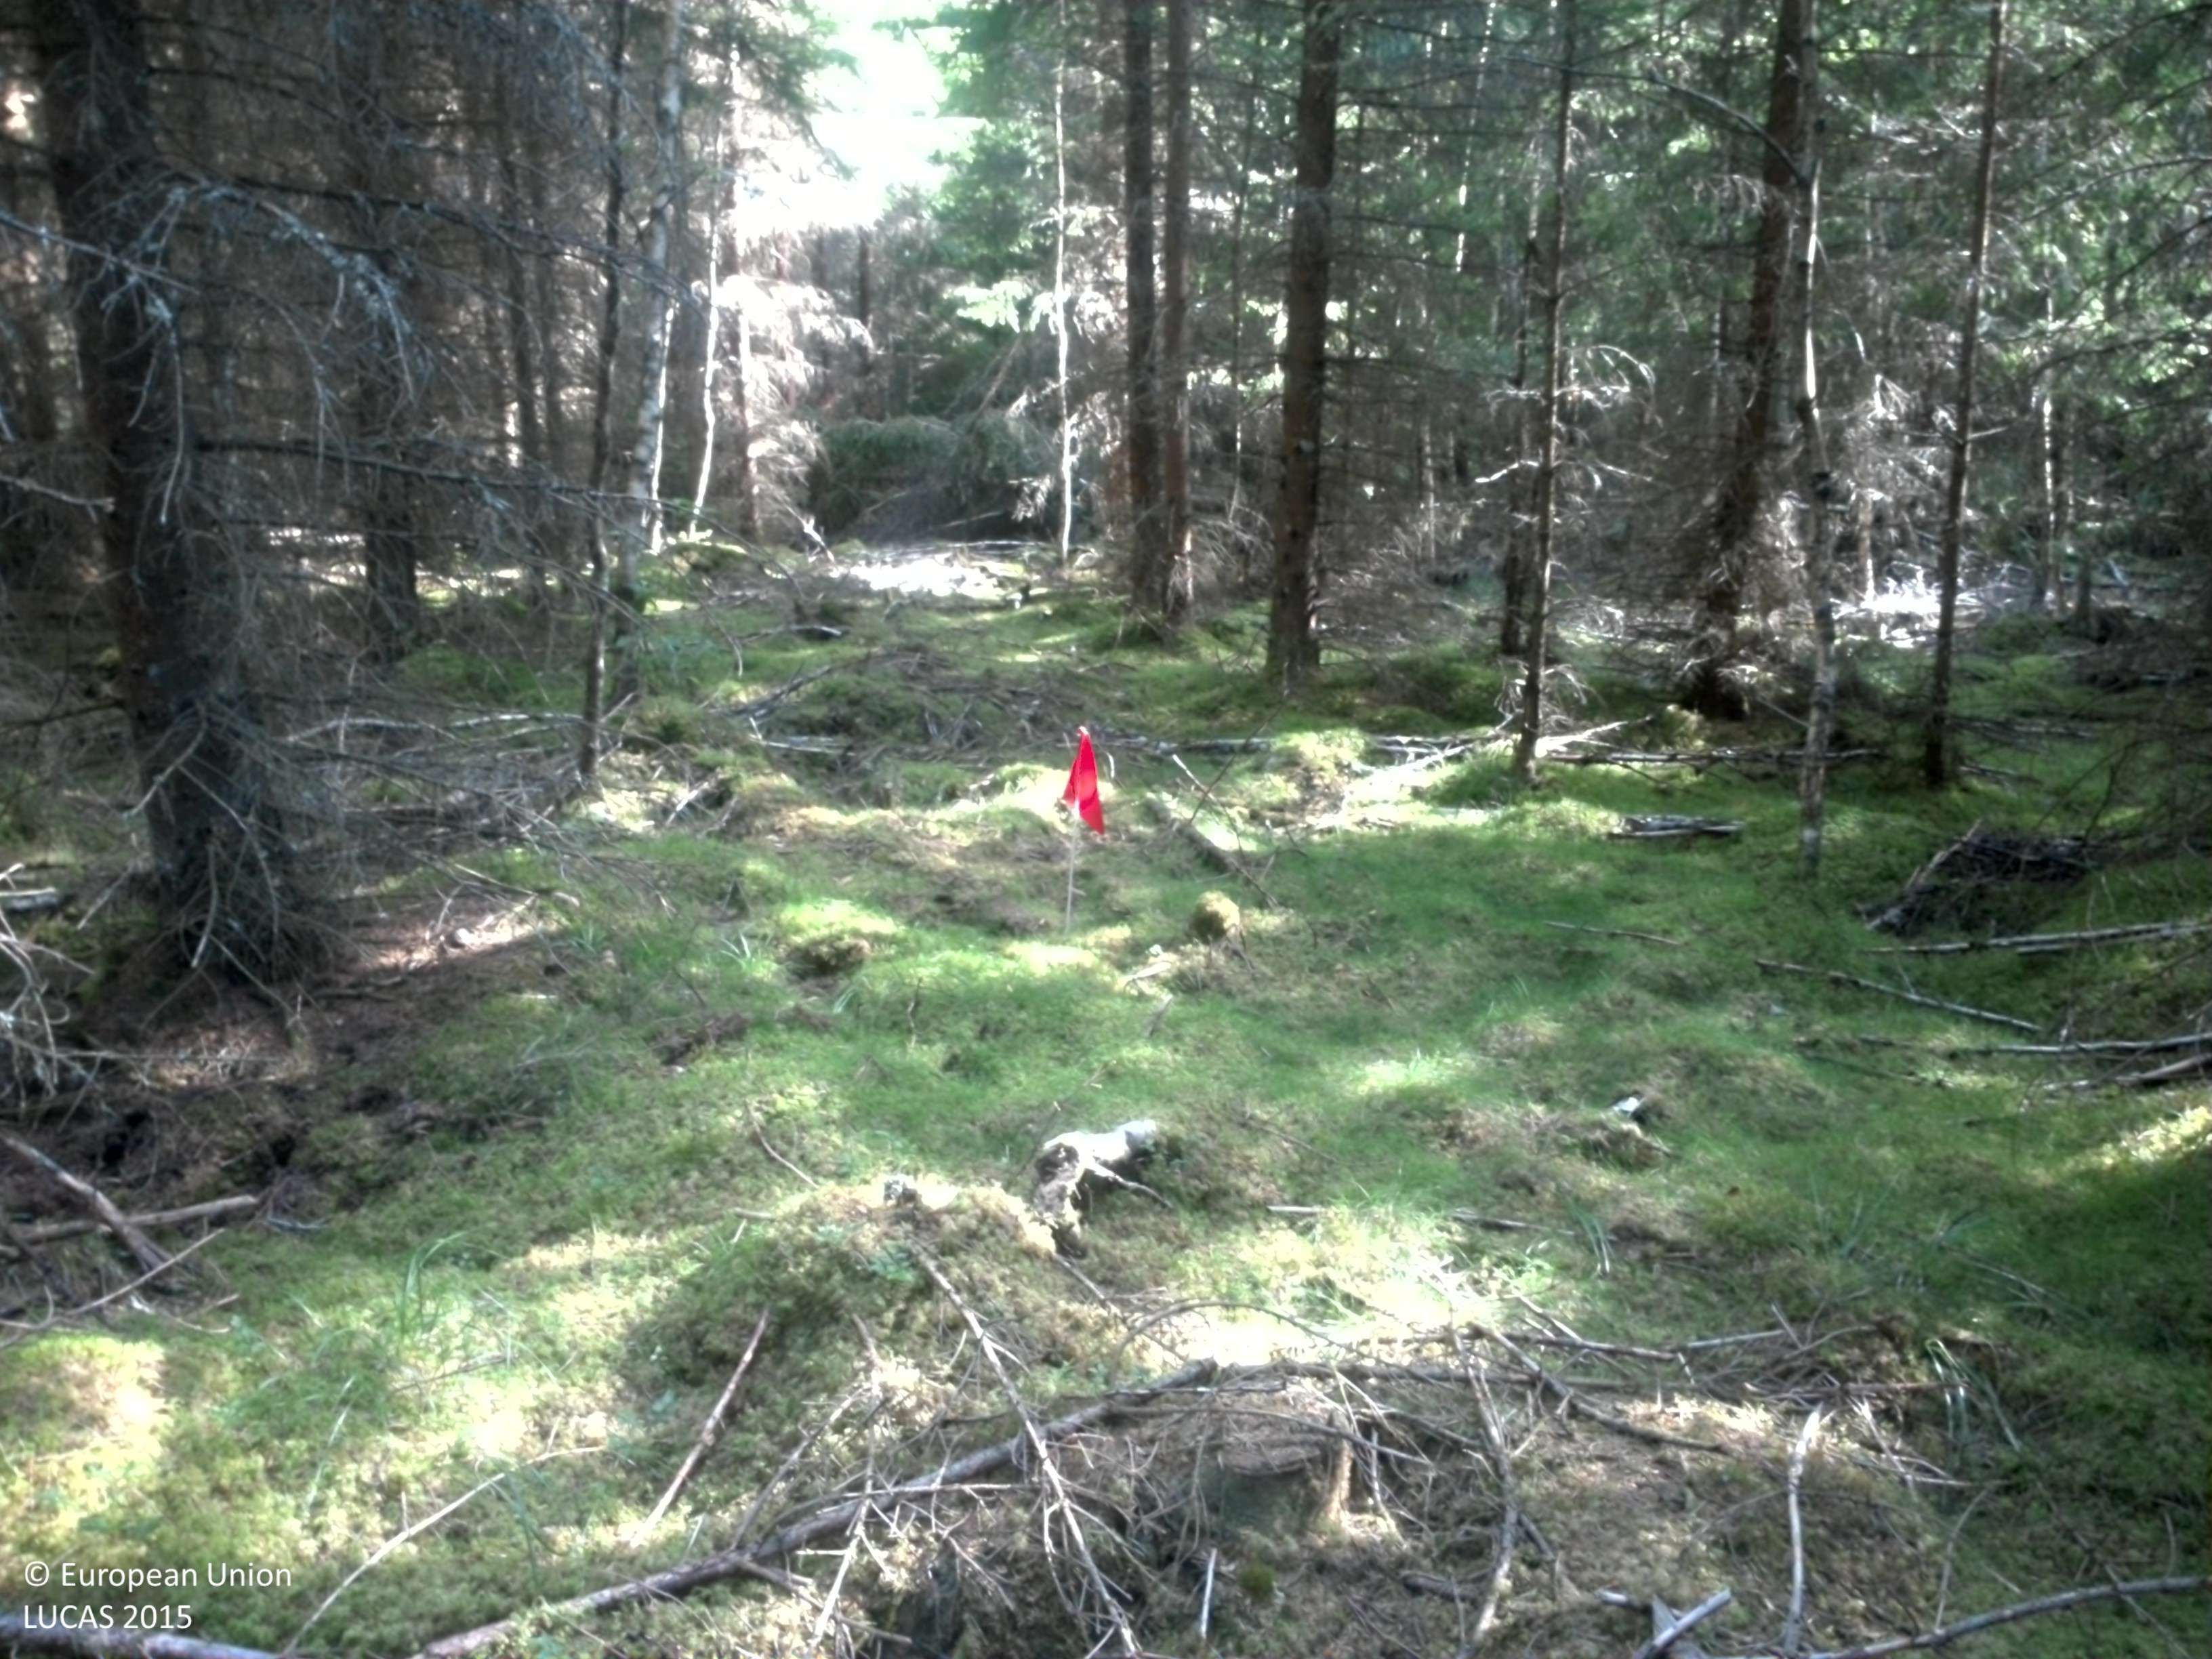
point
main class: Woodland
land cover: Spruce dominated coniferous woodland
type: boreal forest
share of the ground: 50 - 75 %
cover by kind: coniferous forest trees 70 %, lichens and mosses 25 %, herbaceous plants 5 %
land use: Forestry
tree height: > 5 m
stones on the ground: < 10 %
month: August
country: SE
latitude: 58.1608
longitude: 13.3087
